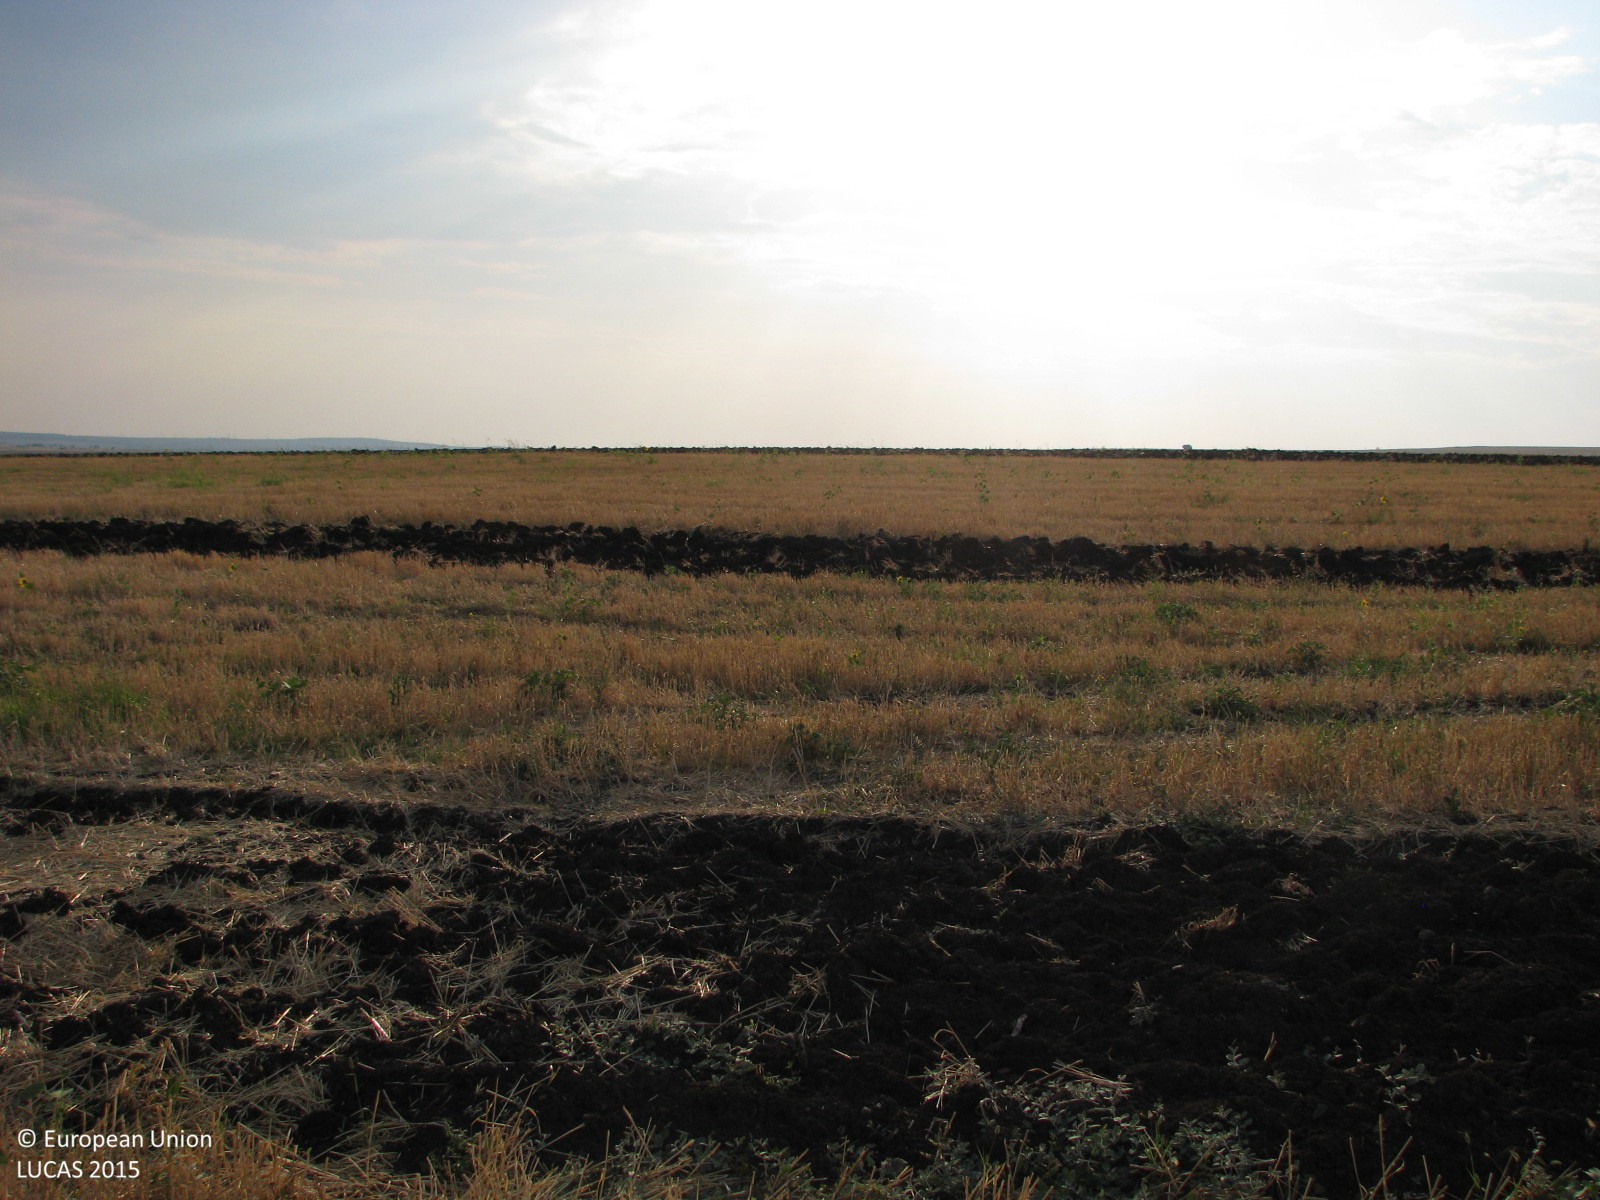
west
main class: Cropland
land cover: Common wheat
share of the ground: > 75 %
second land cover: Spontaneously vegetated surfaces
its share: < 10 %
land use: Agriculture (excluding fallow land and kitchen gardens)
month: August
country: BG
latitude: 42.1977
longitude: 26.3490
